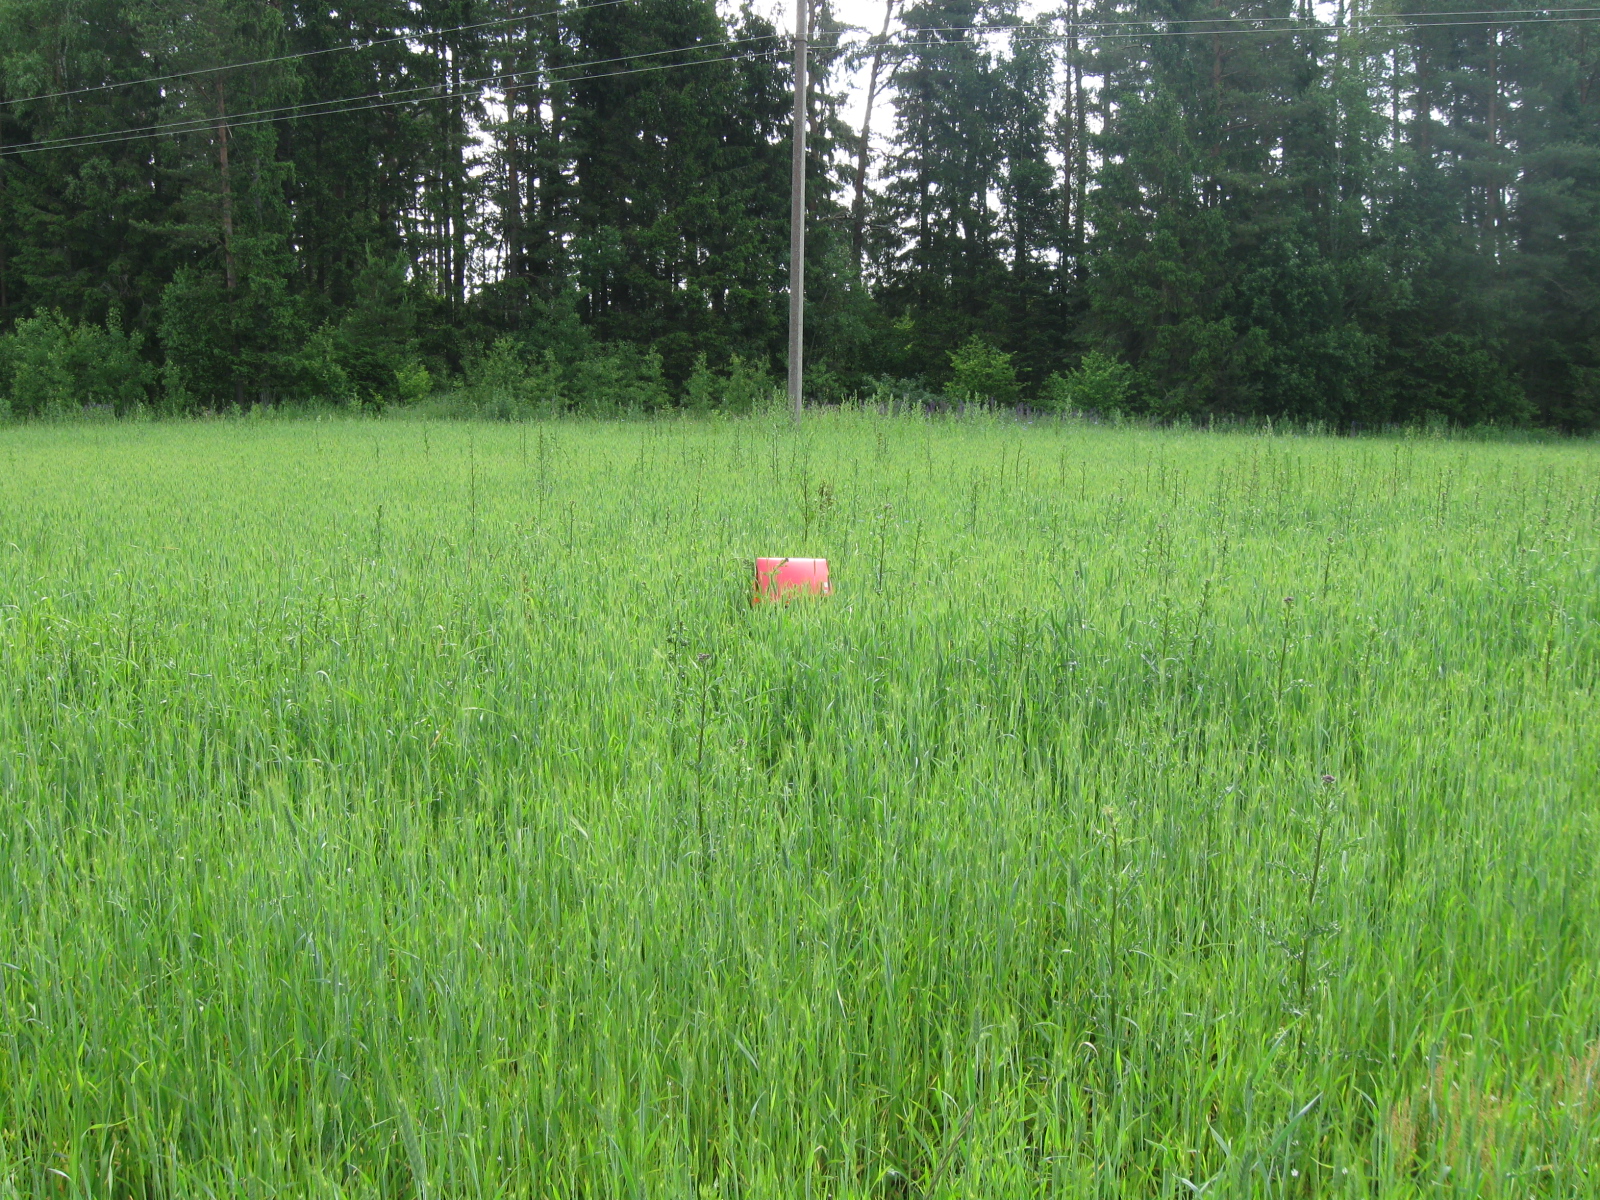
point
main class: Cropland
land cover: Barley
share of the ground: > 75 %
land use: Agriculture (excluding fallow land and kitchen gardens)
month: June
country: LT
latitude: 54.3312
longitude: 24.6703
